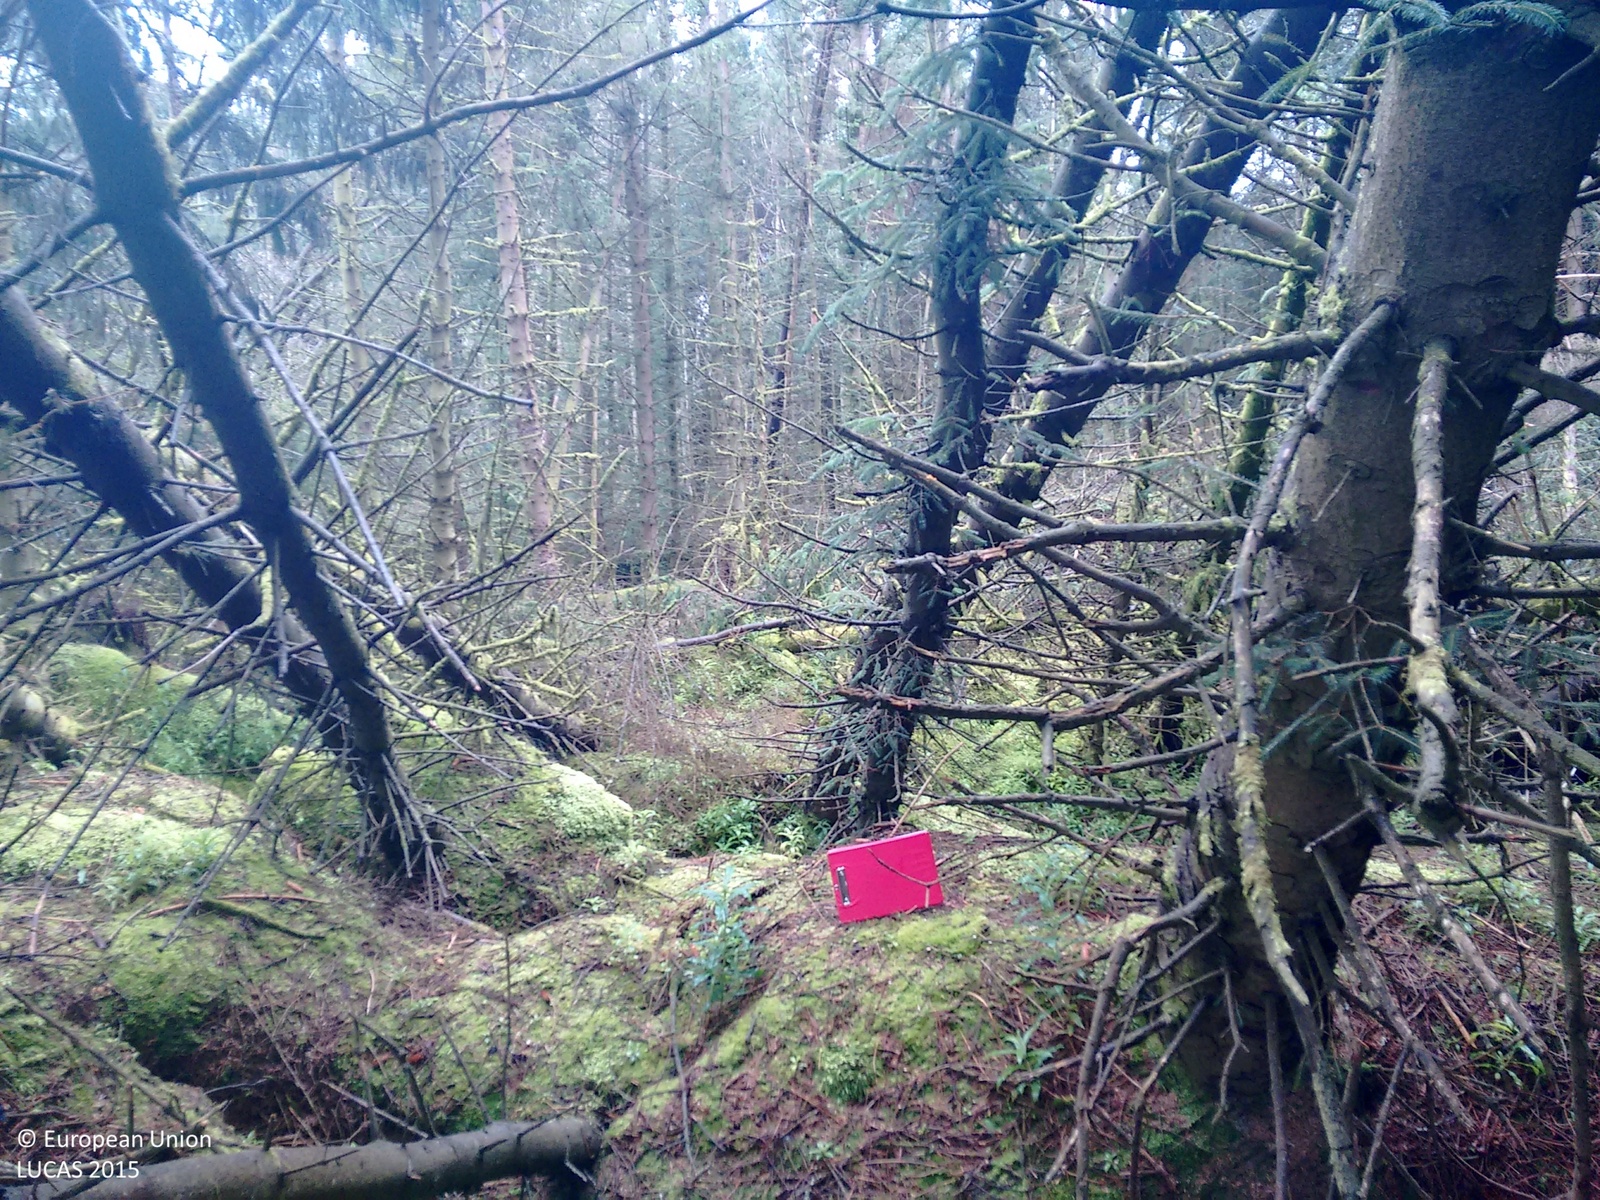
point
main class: Woodland
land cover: Spruce dominated coniferous woodland
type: exotic forest
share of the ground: > 75 %
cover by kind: coniferous forest trees 95 %, lichens and mosses 5 %
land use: Forestry
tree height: > 5 m
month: August
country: GB
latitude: 55.3038
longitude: -3.5168
